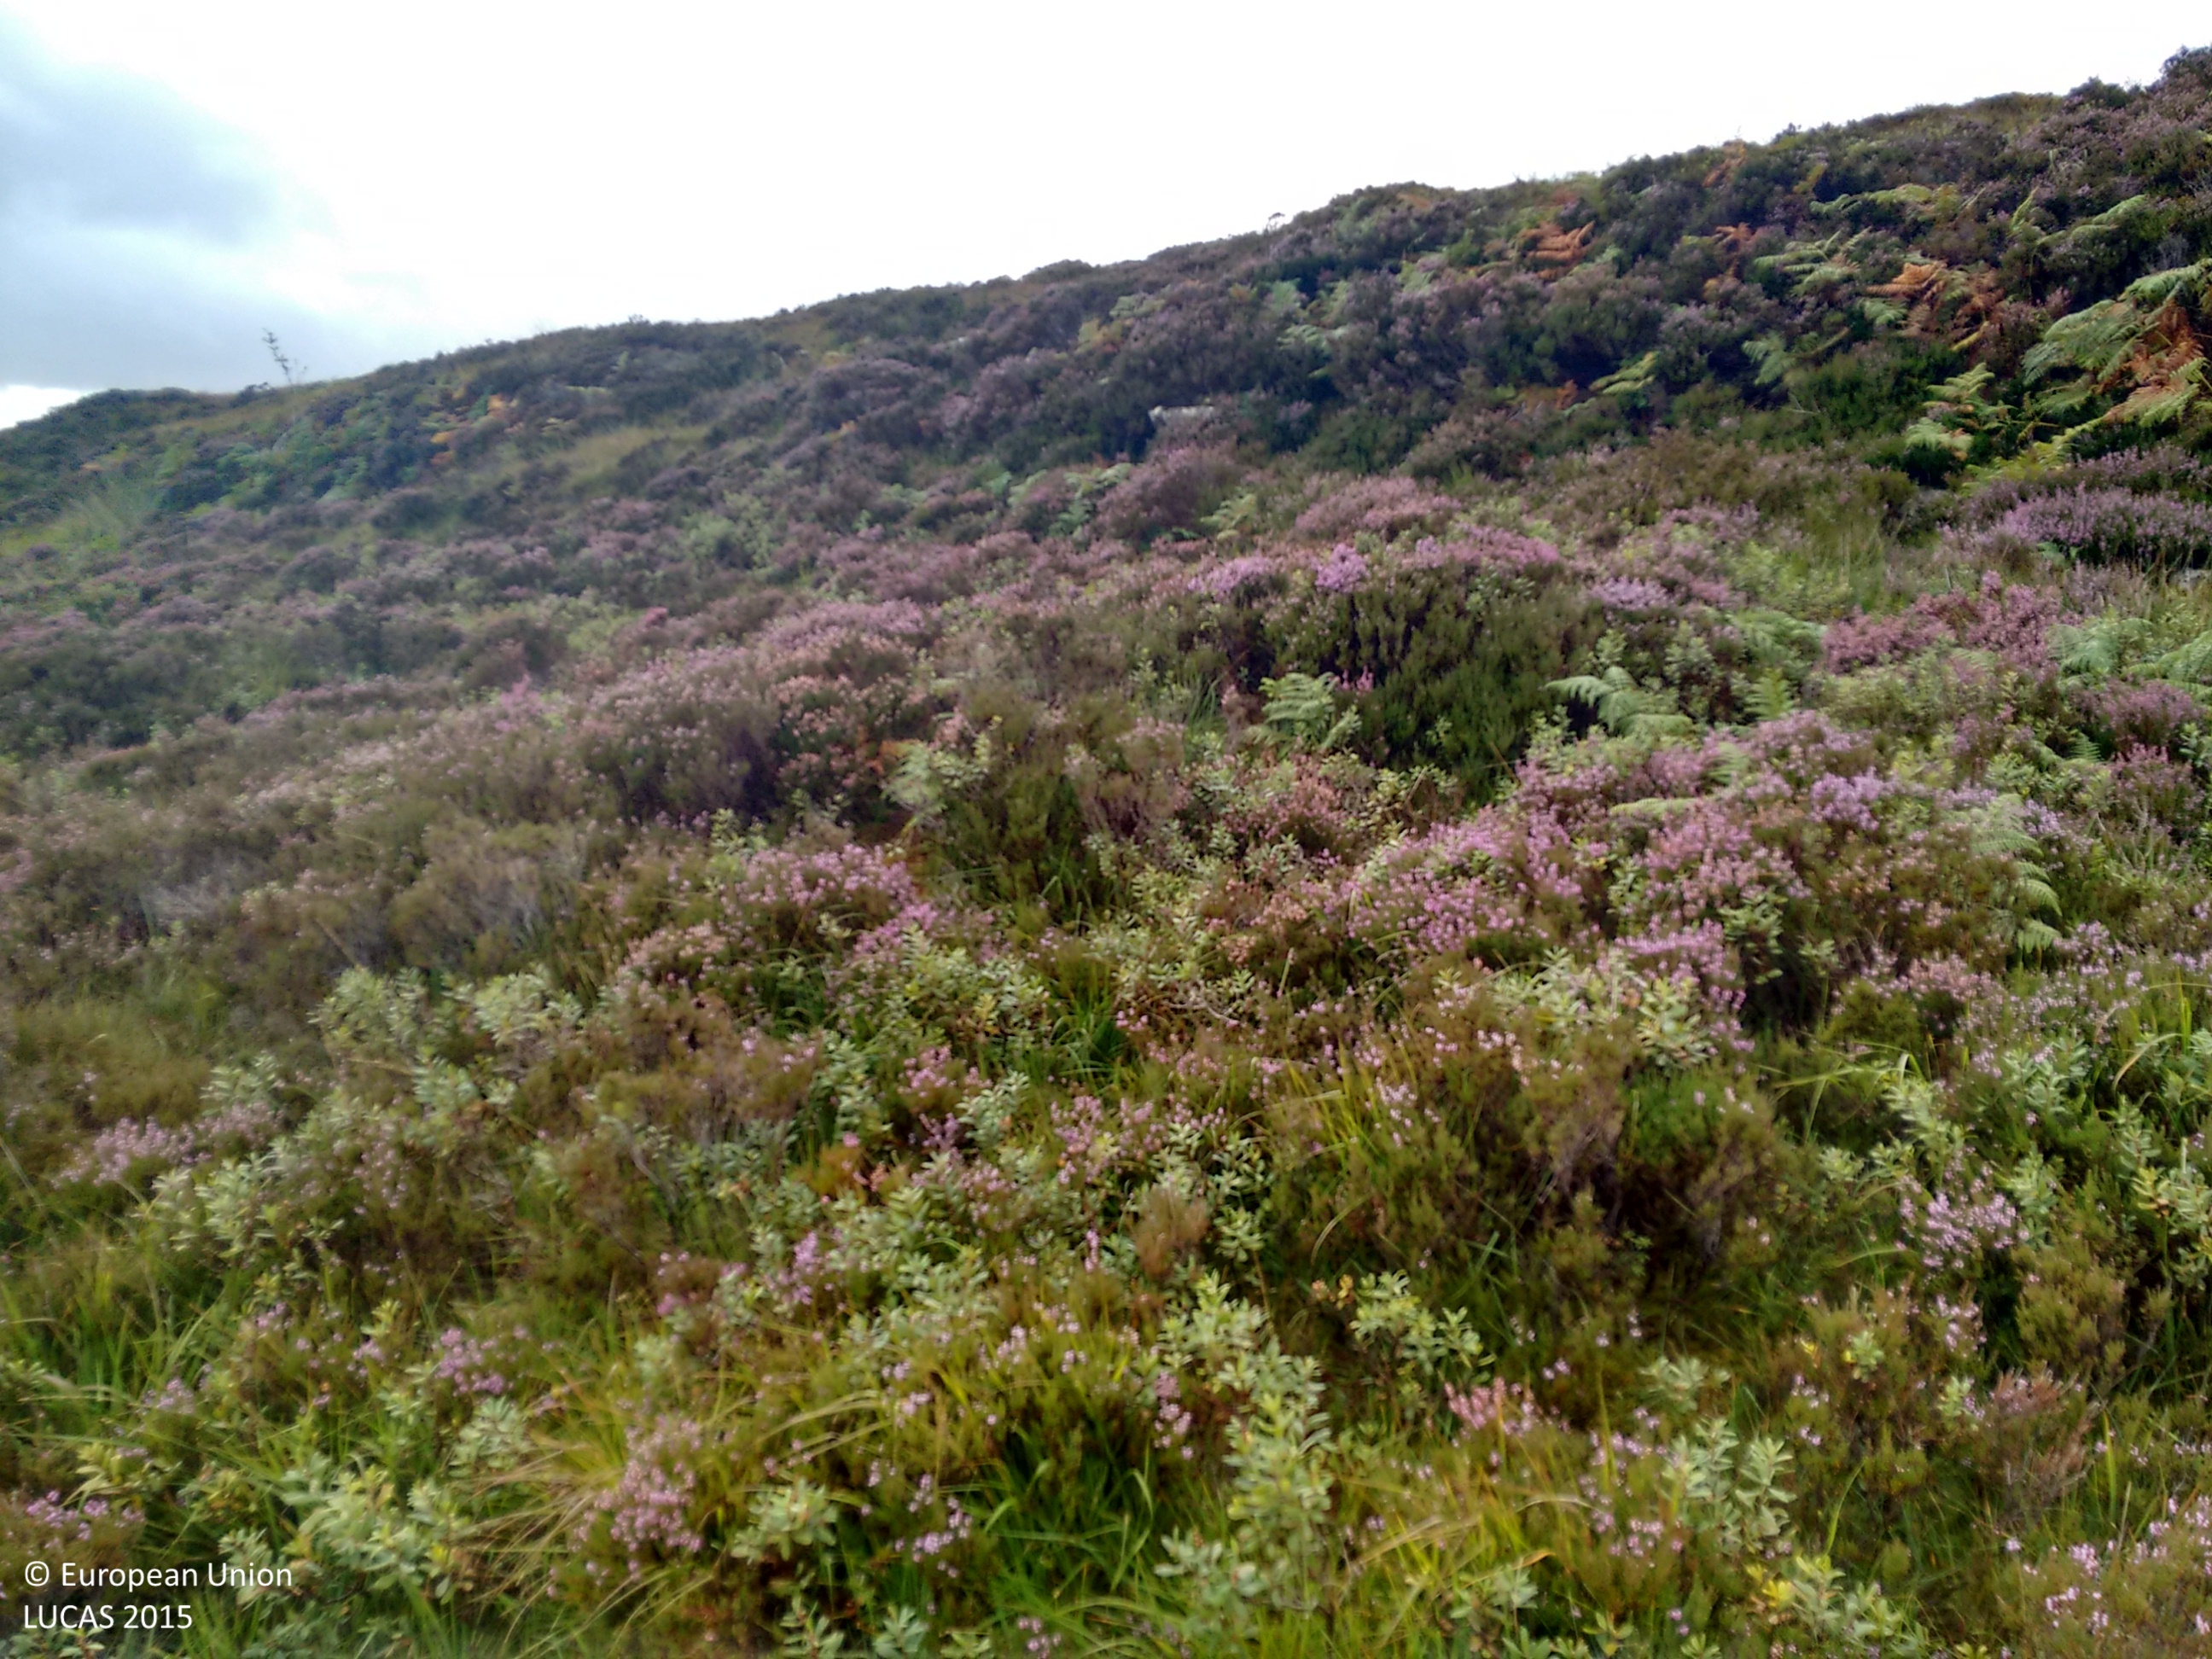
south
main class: Shrubland
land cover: Shrubland without tree cover
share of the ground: > 75 %
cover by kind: shrubs 100 %
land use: Semi-natural and natural areas not in use
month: September
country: GB
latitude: 57.1705
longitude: -6.0583
